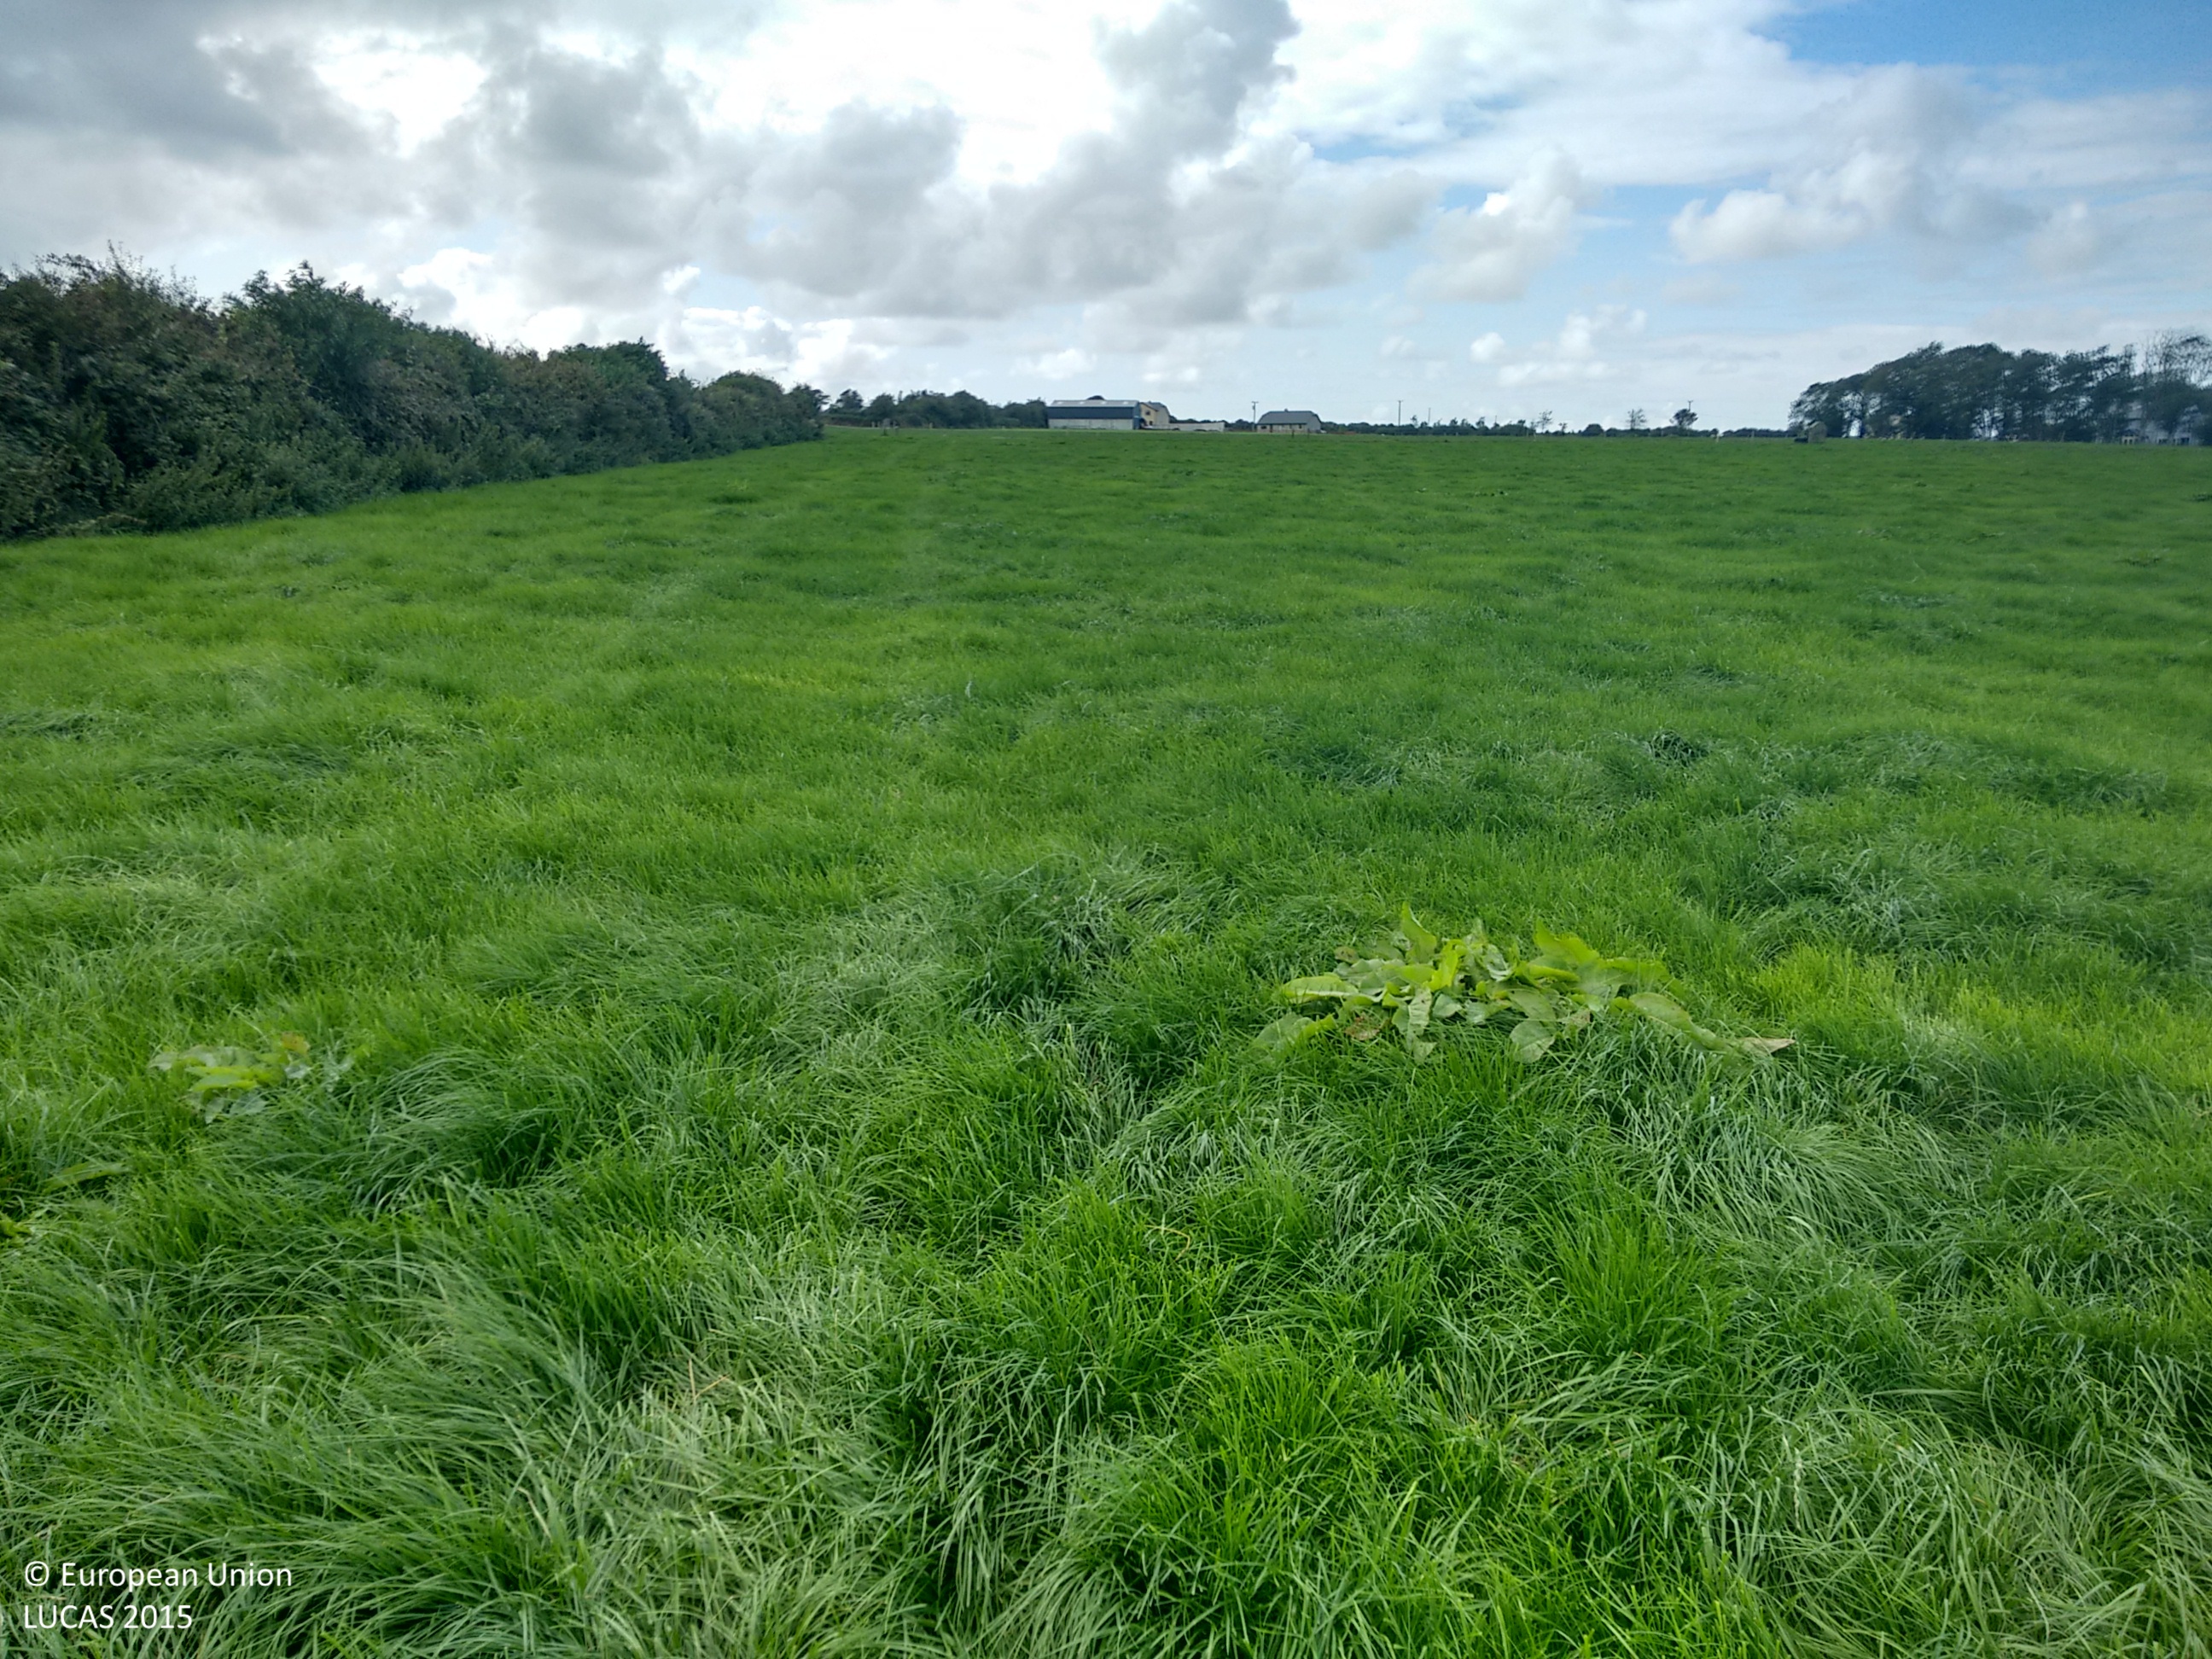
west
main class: Grassland
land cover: Grassland without tree/shrub cover
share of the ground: > 75 %
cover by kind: herbaceous plants 95 %, shrubs 5 %
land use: Agriculture (excluding fallow land and kitchen gardens)
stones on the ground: < 10 %
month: September
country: IE
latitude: 52.3482
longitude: -9.7230
